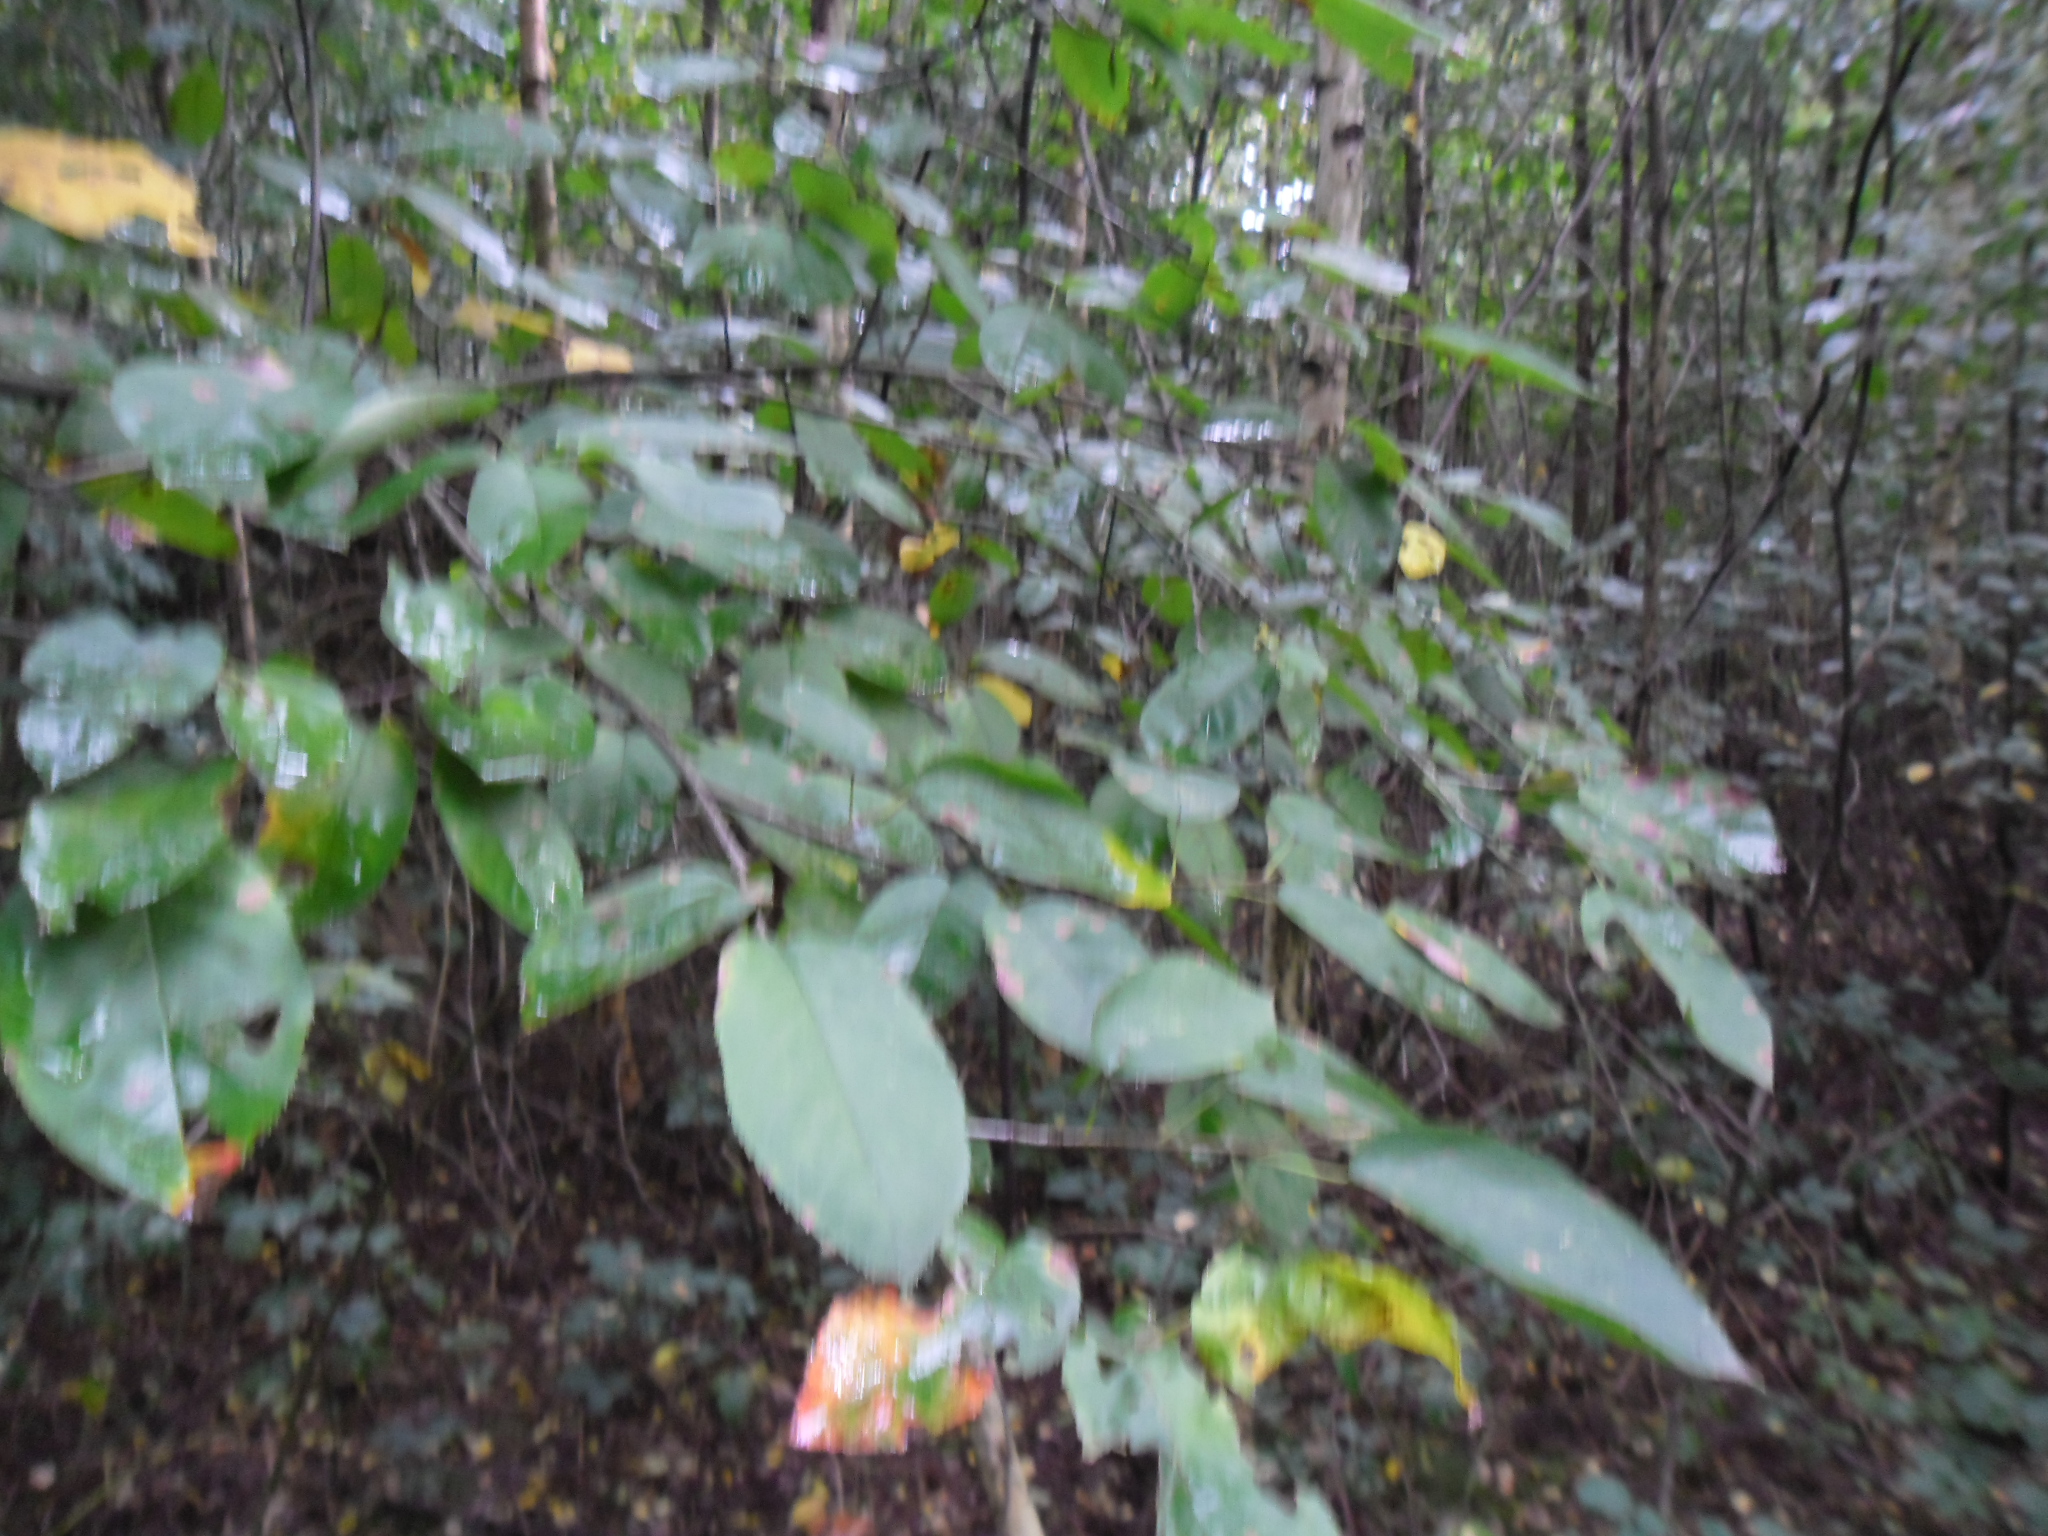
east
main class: Woodland
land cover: Other mixed woodland
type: mesophytic deciduous forest
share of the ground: > 75 %
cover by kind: broadleaved forest trees 60 %, coniferous forest trees 40 %
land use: Amenities, museums, leisure
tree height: > 5 m
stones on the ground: < 10 %
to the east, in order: Other mixed woodland; Ditches and canals; Tracks; Broadleaved woodland; Ditches and canals; Fences; Grassland without tree/shrub cover; Fences; Ditches and canals; Fences; Grassland without tree/shrub cover; Fences; Lines of trees; Ditches and canals; Grassland without tree/shrub cover
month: September
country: NL
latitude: 52.1296
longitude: 5.4844
